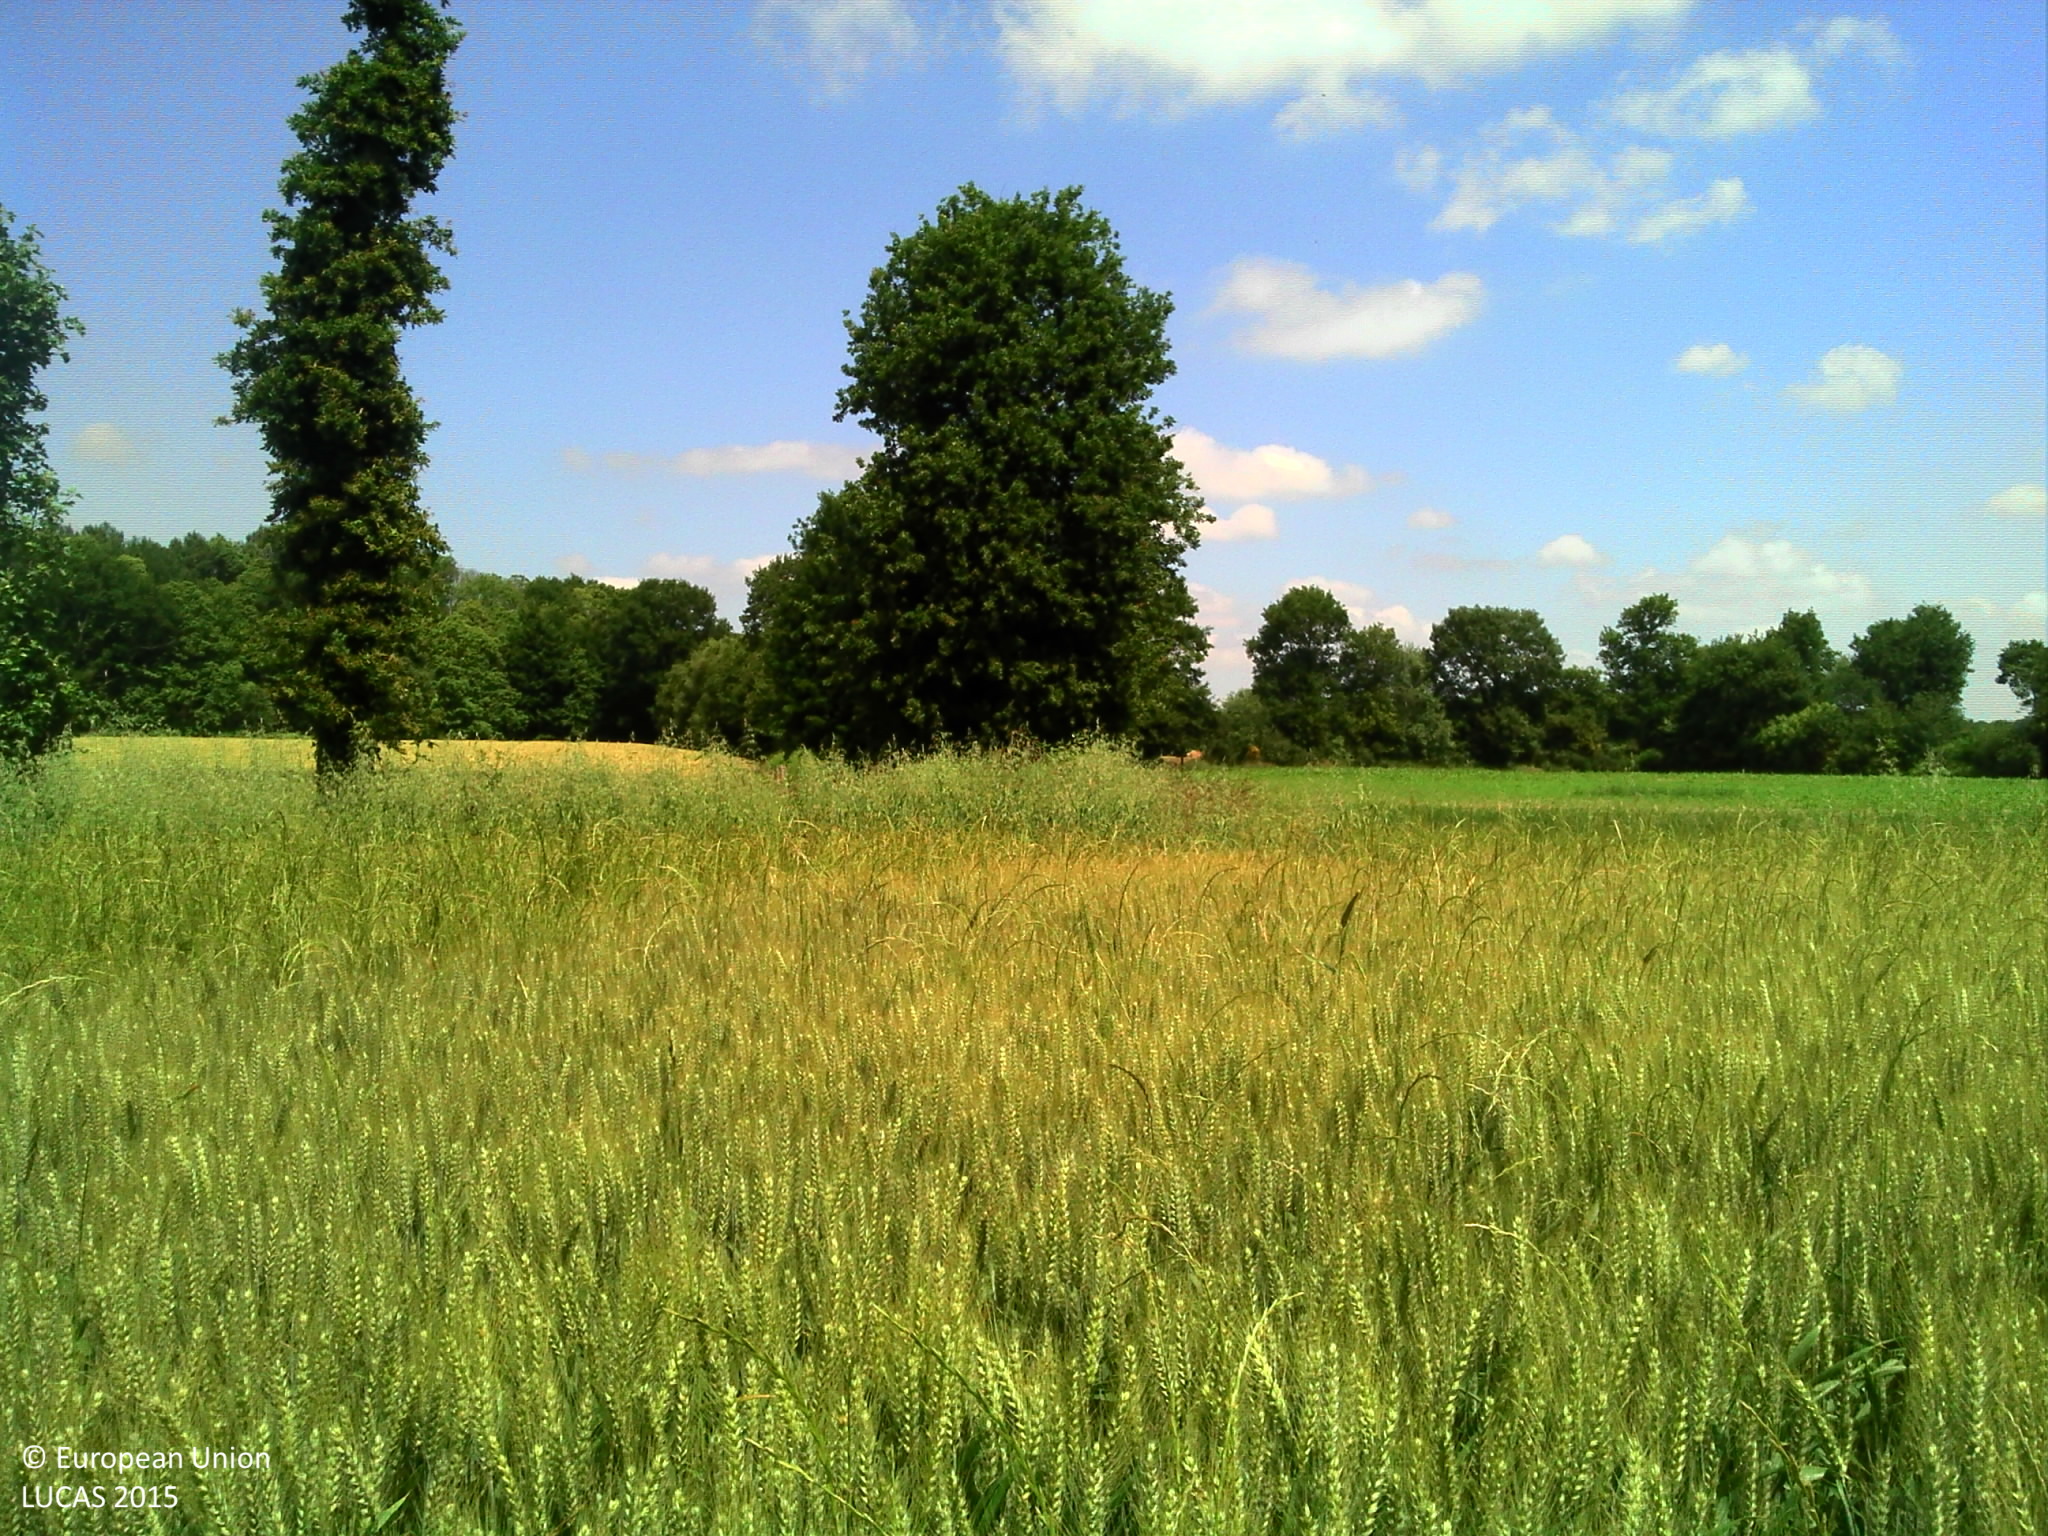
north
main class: Cropland
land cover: Common wheat
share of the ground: > 75 %
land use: Agriculture (excluding fallow land and kitchen gardens)
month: June
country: FR
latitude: 47.9964
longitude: -1.8840
